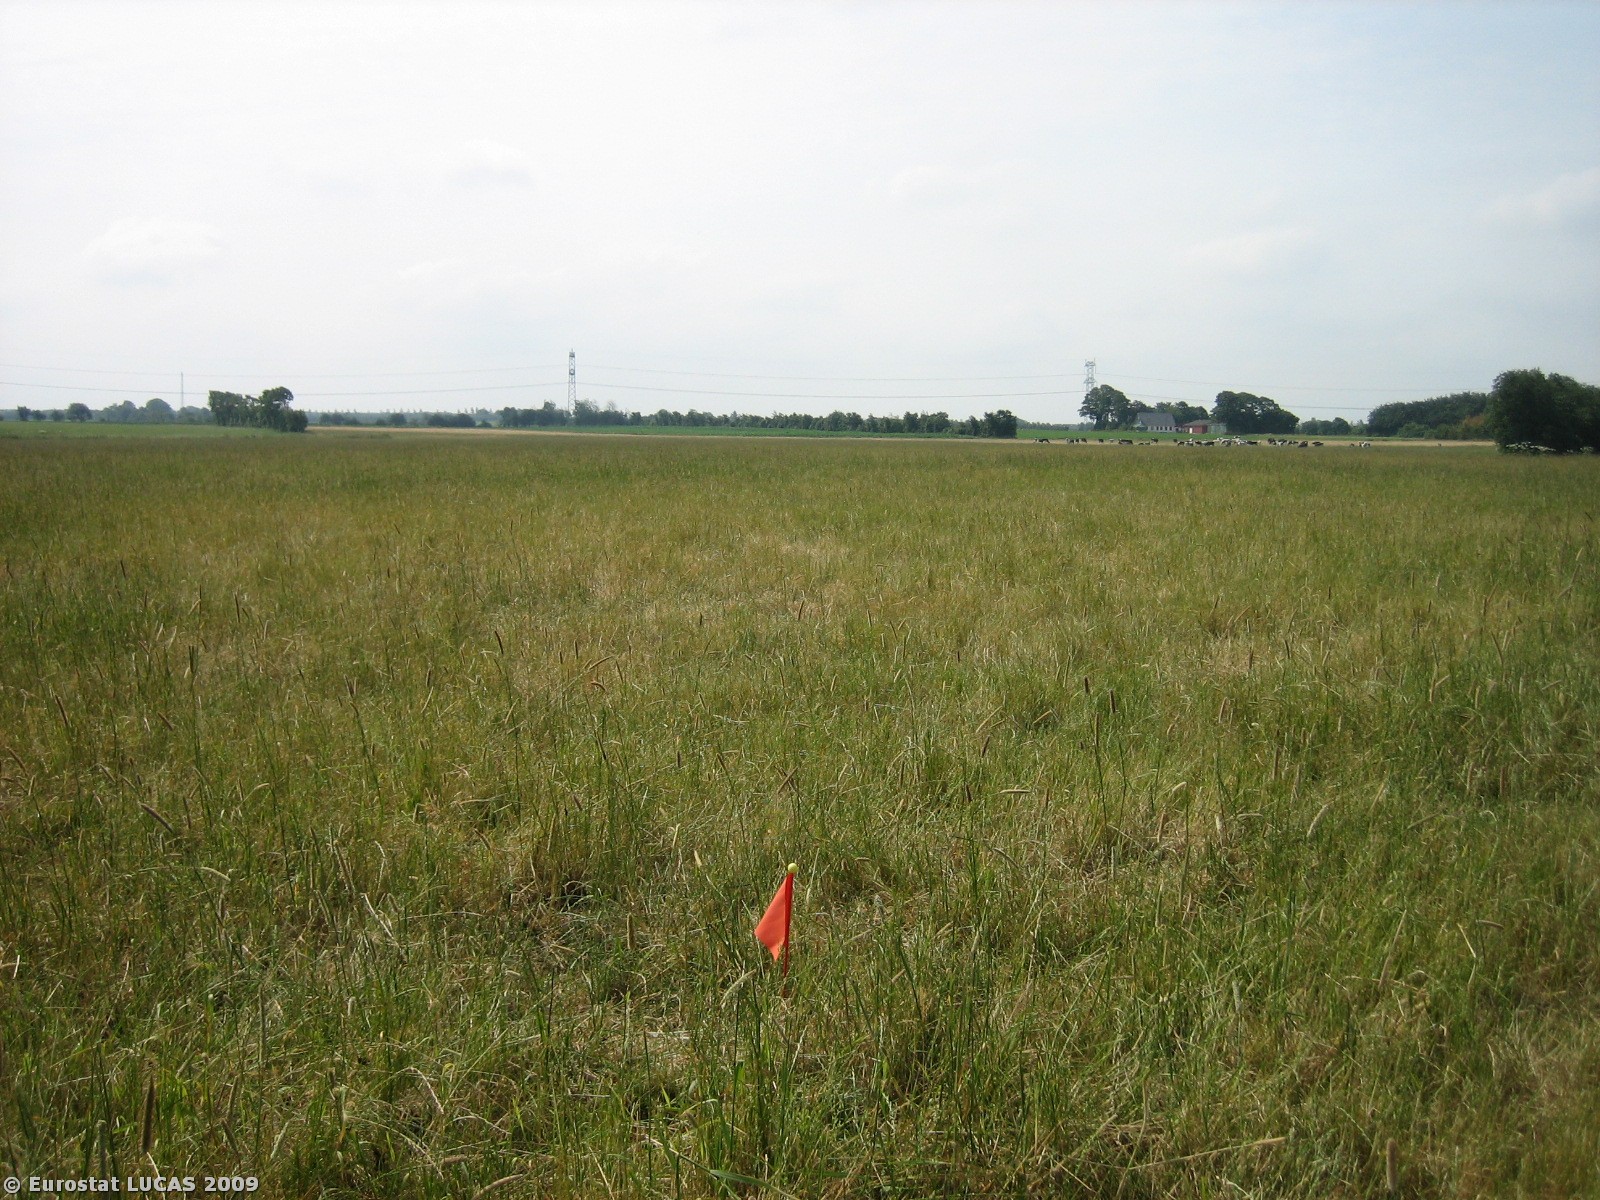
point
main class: Grassland
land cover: Grassland without tree/shrub cover
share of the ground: > 75 %
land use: Agriculture (excluding fallow land and kitchen gardens)
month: July
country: DK
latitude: 55.5354
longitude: 8.8444
